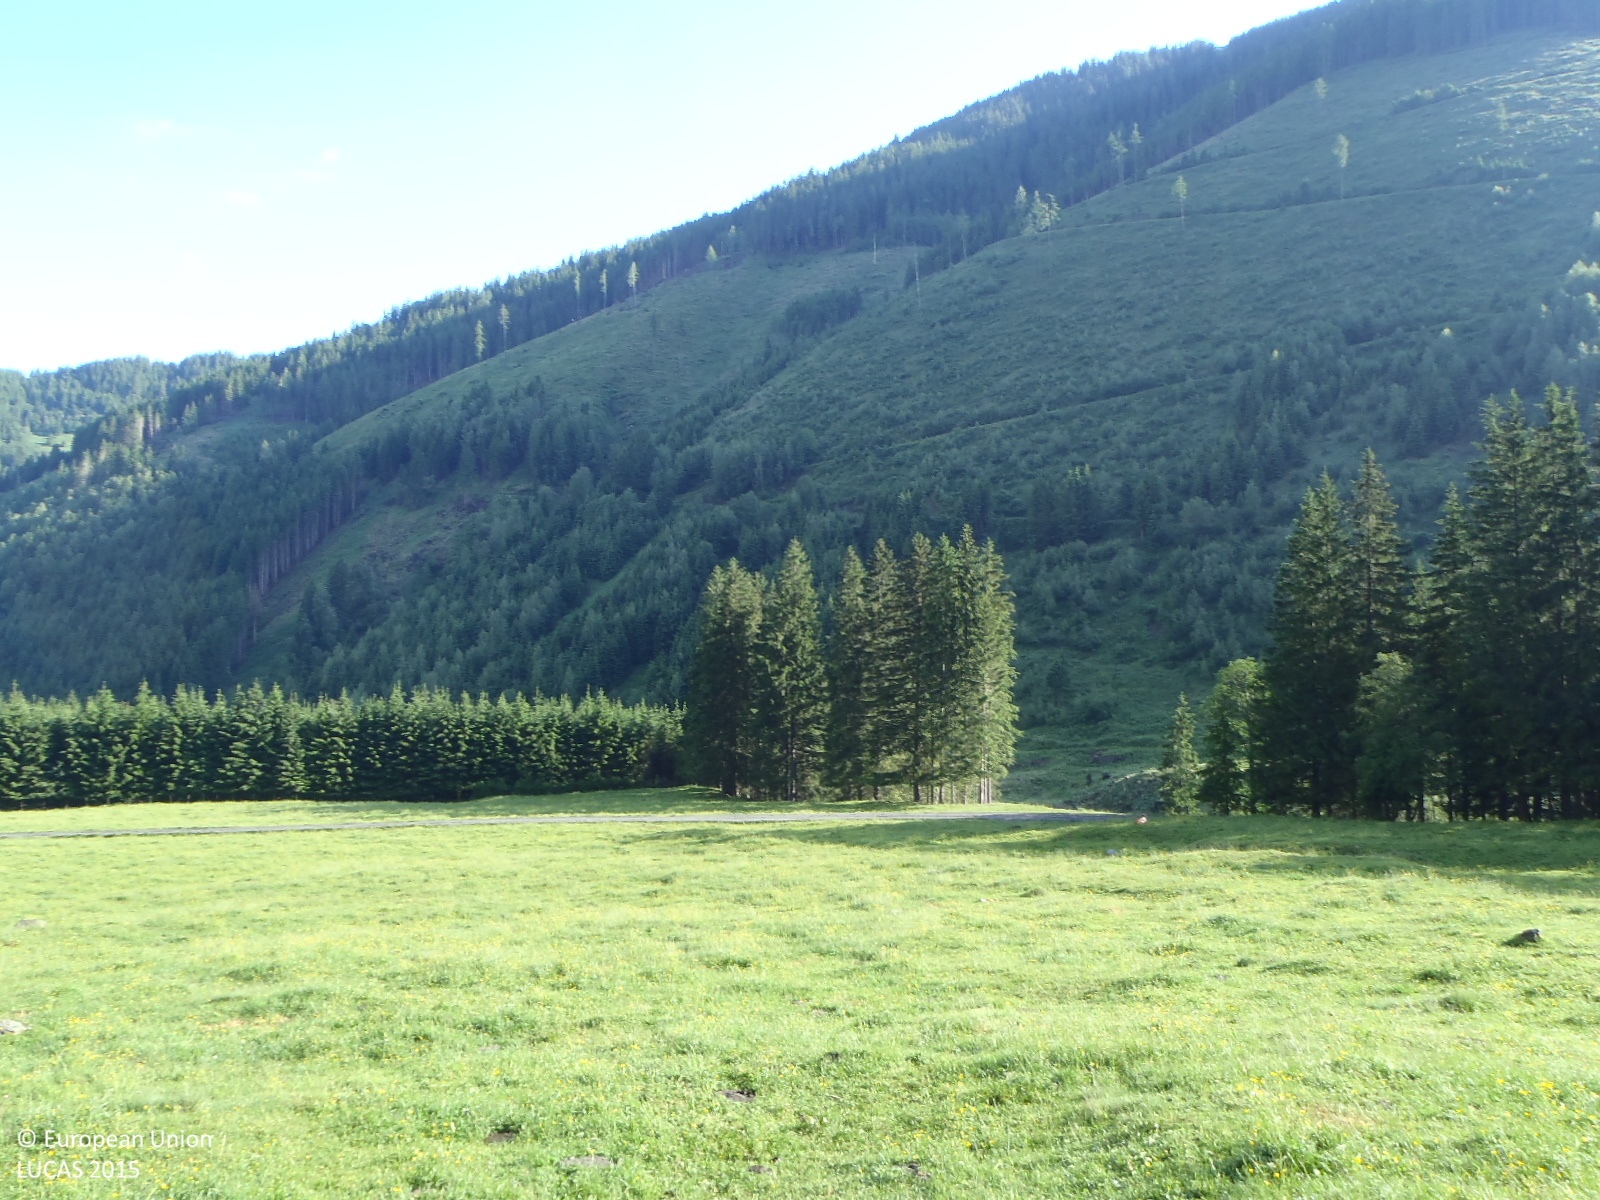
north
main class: Grassland
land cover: Grassland without tree/shrub cover
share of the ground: > 75 %
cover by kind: herbaceous plants 100 %
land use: Agriculture (excluding fallow land and kitchen gardens)
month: June
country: AT
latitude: 47.1959
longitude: 12.8622
